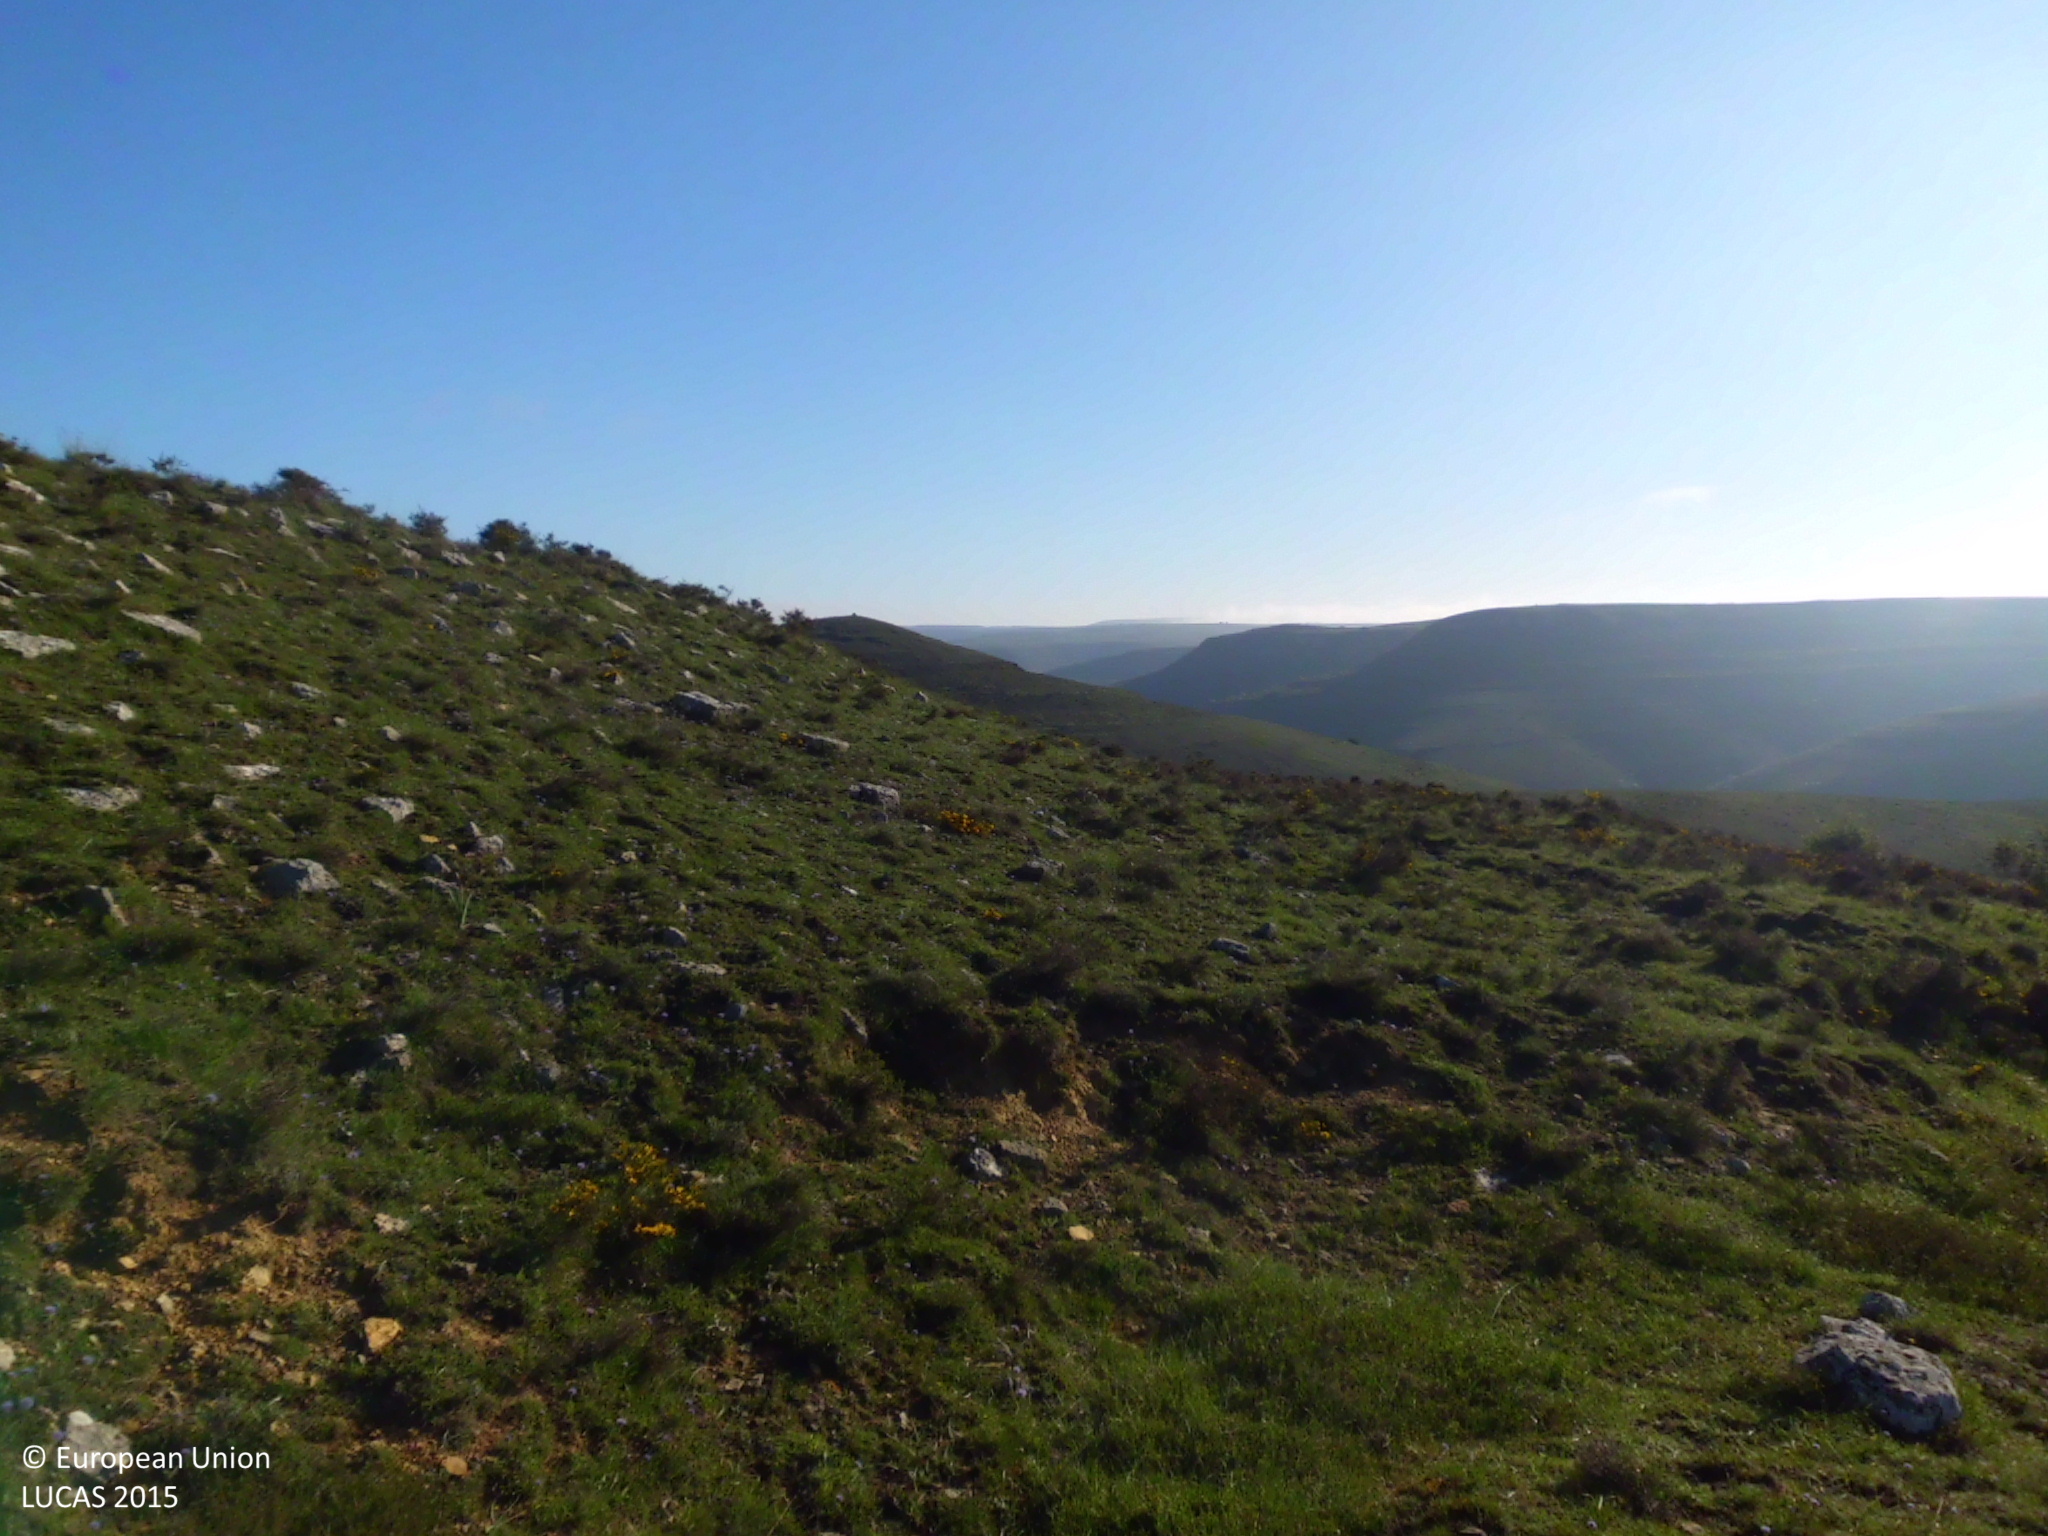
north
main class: Shrubland
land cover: Shrubland without tree cover
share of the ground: 50 - 75 %
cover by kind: shrubs 60 %, herbaceous plants 40 %
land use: Abandoned areas
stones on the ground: 25 - 50 %
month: May
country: ES
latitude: 42.6813
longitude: -3.7454
